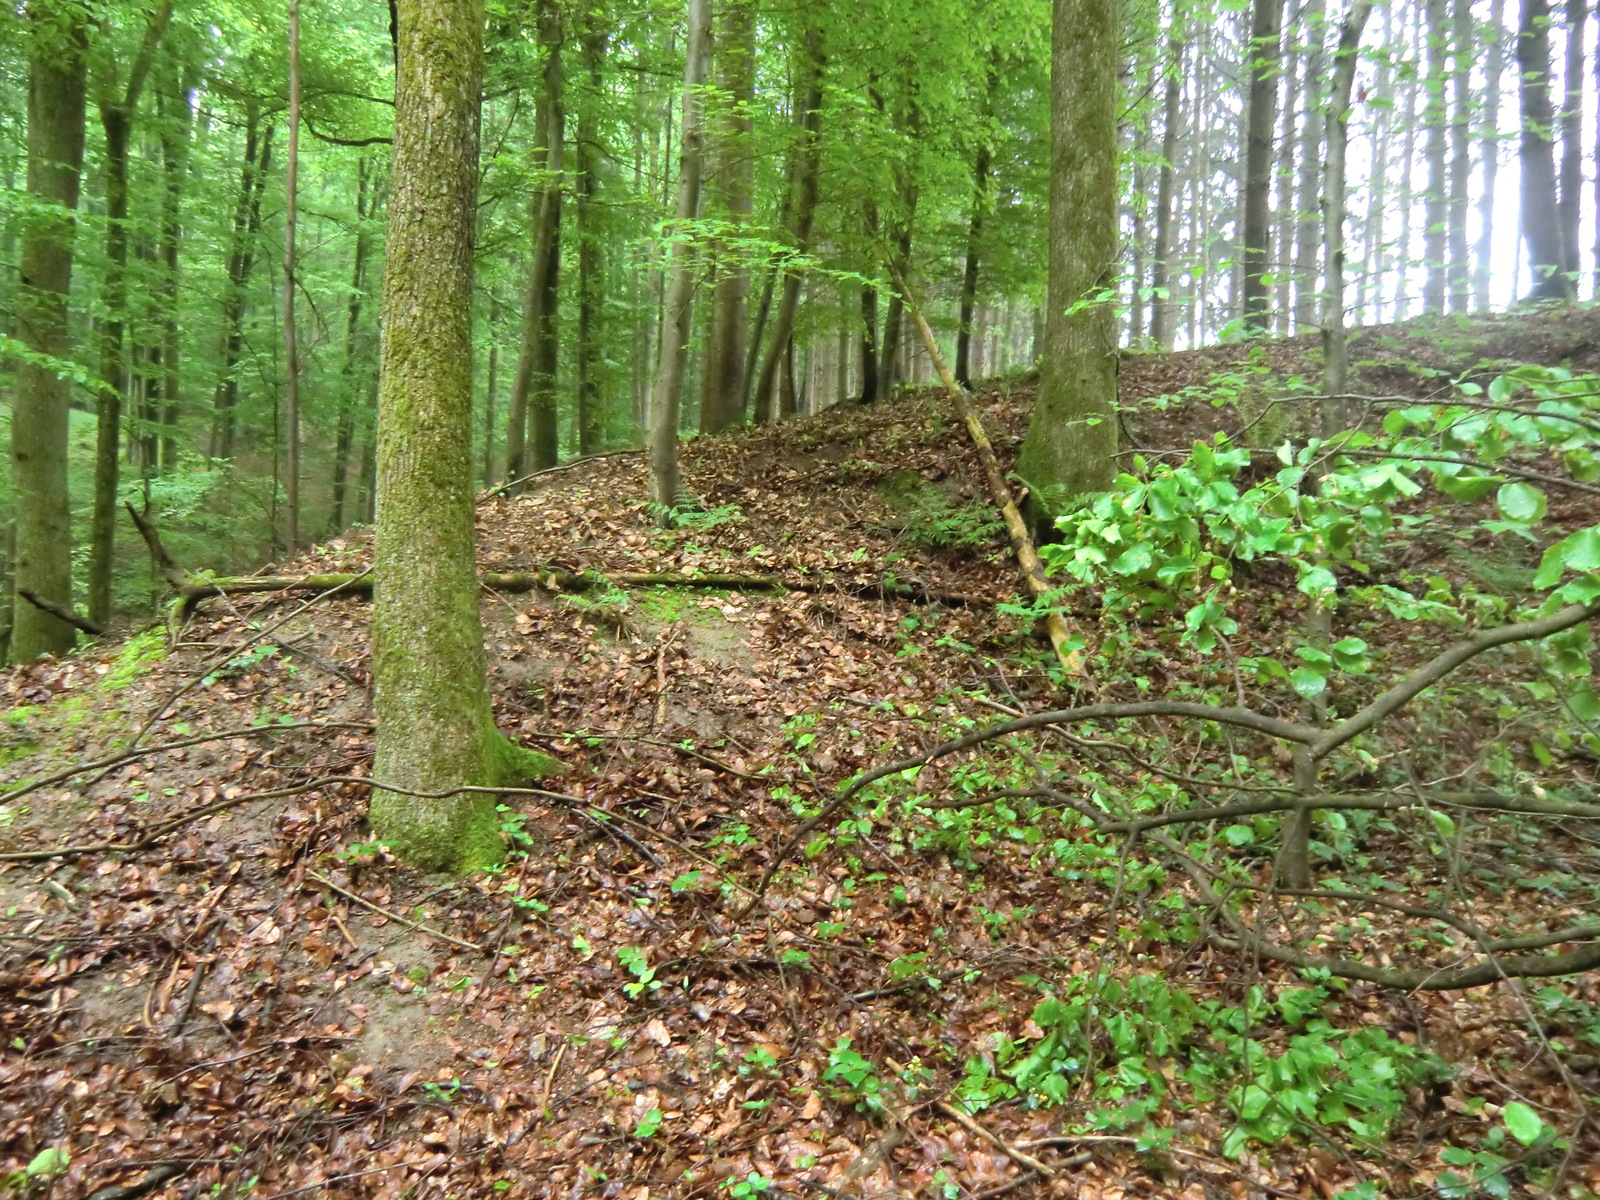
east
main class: Woodland
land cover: Broadleaved woodland
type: beech forest
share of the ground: > 75 %
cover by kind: broadleaved forest trees 80 %, unconsolidated bare surface 15 %, herbaceous plants 5 %
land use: Forestry
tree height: > 5 m
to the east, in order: Broadleaved woodland; Ditches and canals; Broadleaved woodland; Spruce dominated coniferous woodland; Broadleaved woodland; Tracks; Grassland without tree/shrub cover; Broadleaved woodland
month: May
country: AT
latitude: 48.2292
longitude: 14.7529
